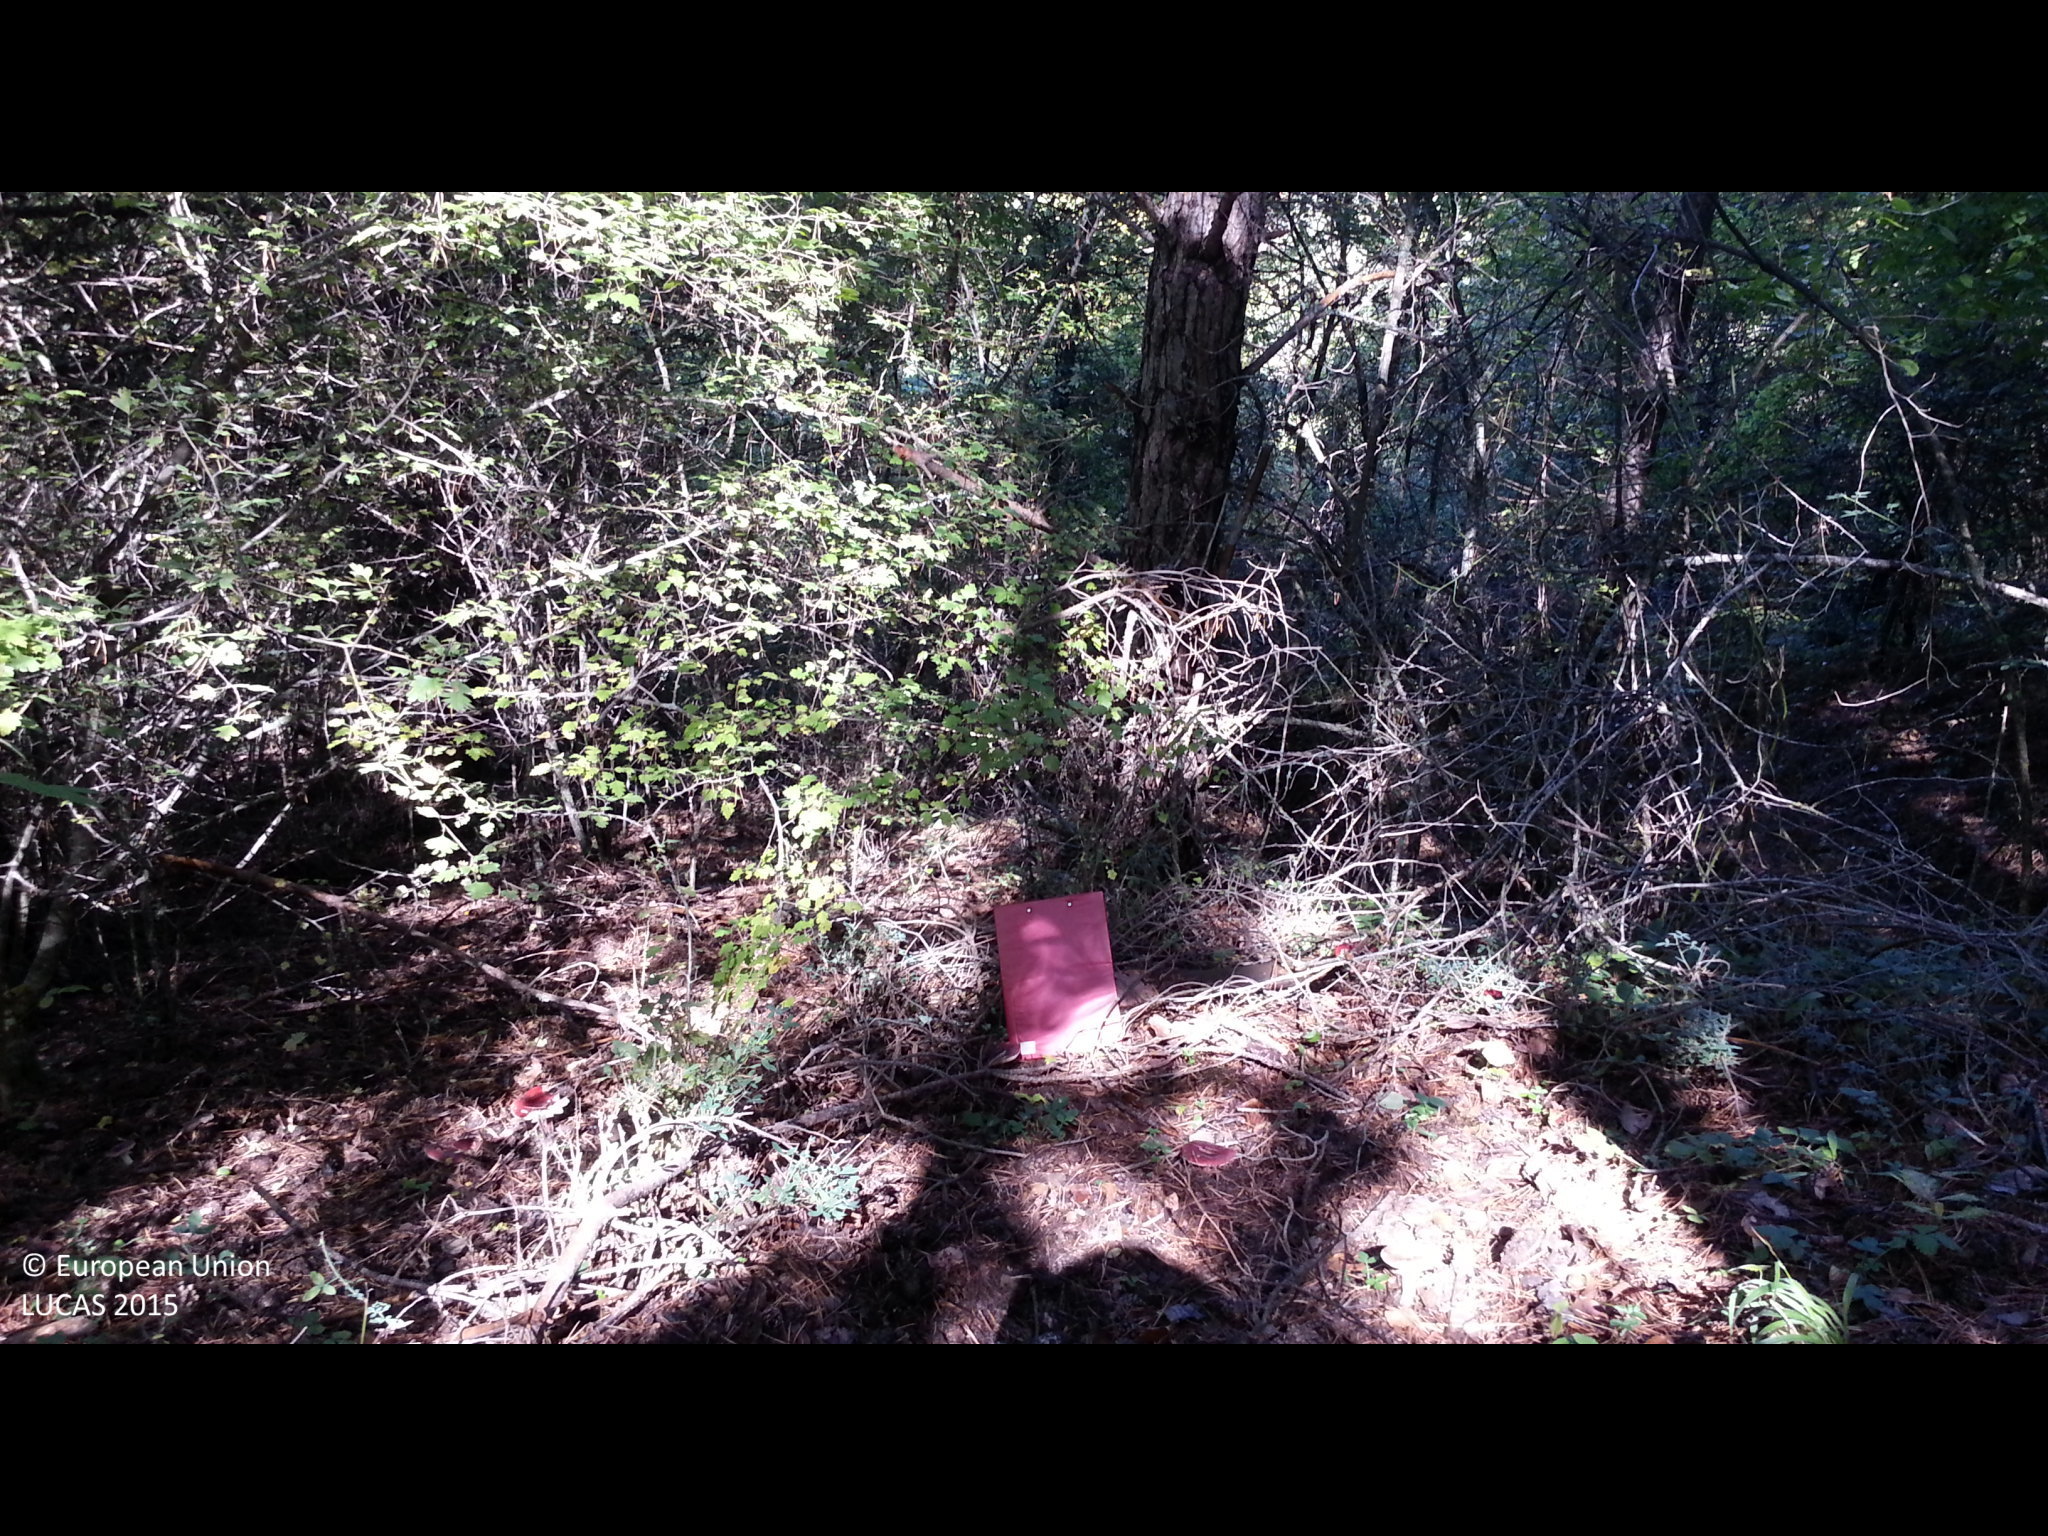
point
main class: Woodland
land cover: Other mixed woodland
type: hemiboreal forest and nemoral coniferous forest and mixed broadleaved-coniferous forest
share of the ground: > 75 %
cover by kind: coniferous forest trees 40 %, broadleaved forest trees 40 %, unconsolidated bare surface 10 %, shrubs 5 %, herbaceous plants 5 %
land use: Forestry
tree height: > 5 m
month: October
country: BG
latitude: 42.6843
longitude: 22.6073
